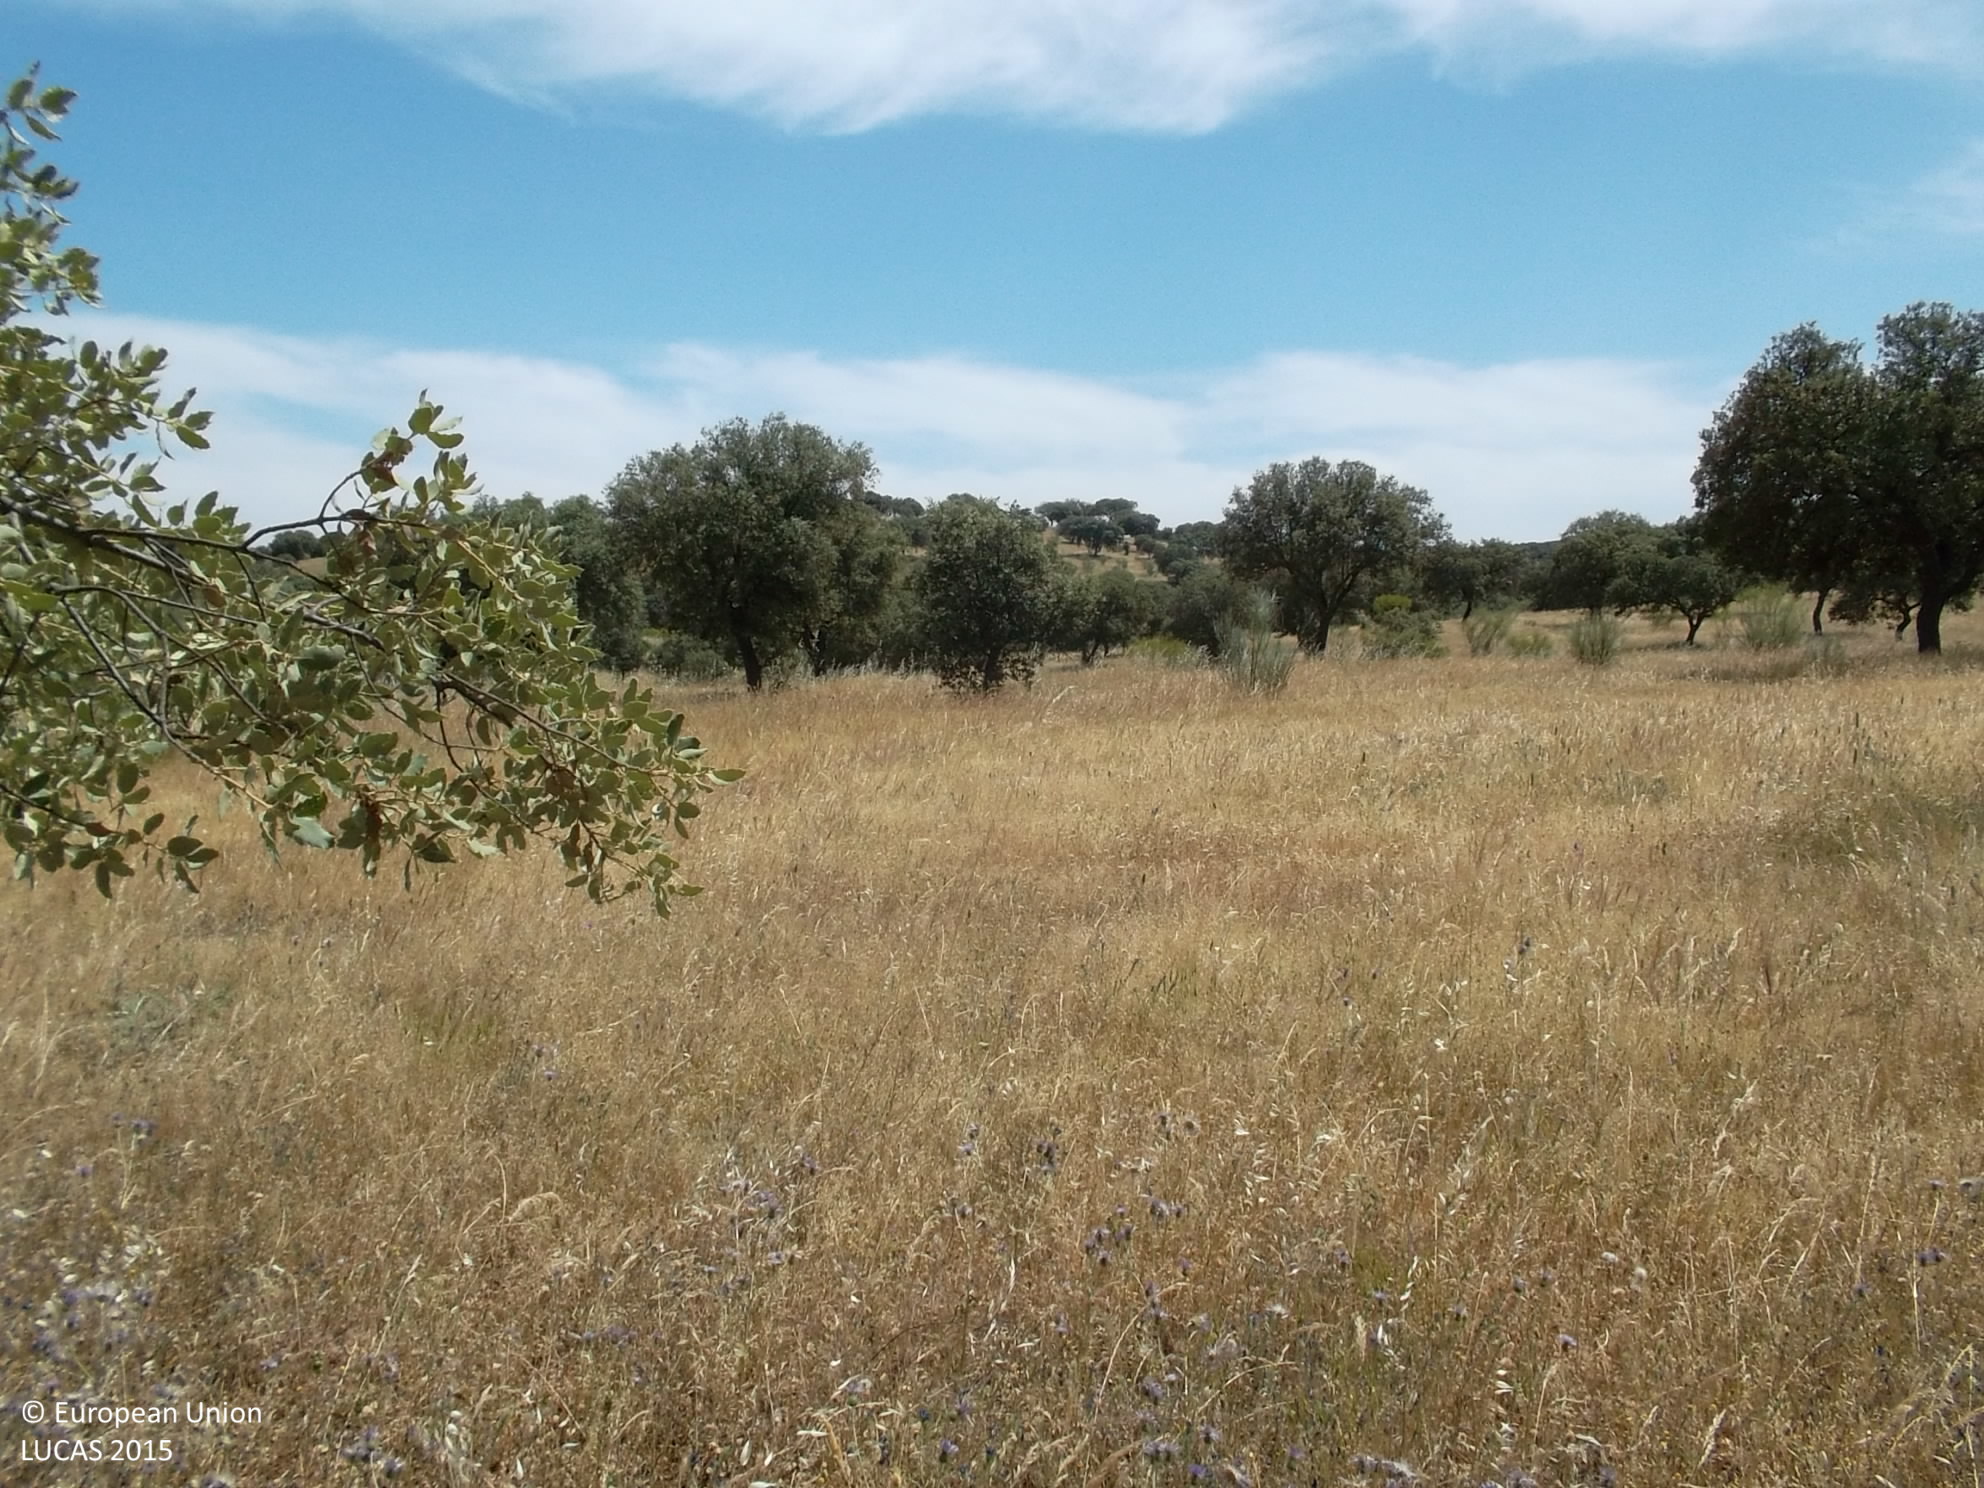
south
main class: Woodland
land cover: Broadleaved woodland
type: broadleaved evergreen forest
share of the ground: 25 - 50 %
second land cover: Spontaneously vegetated surfaces
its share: > 75 %
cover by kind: herbaceous plants 70 %, broadleaved forest trees 30 %
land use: Forestry
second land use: Agriculture (excluding fallow land and kitchen gardens)
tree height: > 5 m
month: May
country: ES
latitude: 38.6967
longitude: -4.8025
